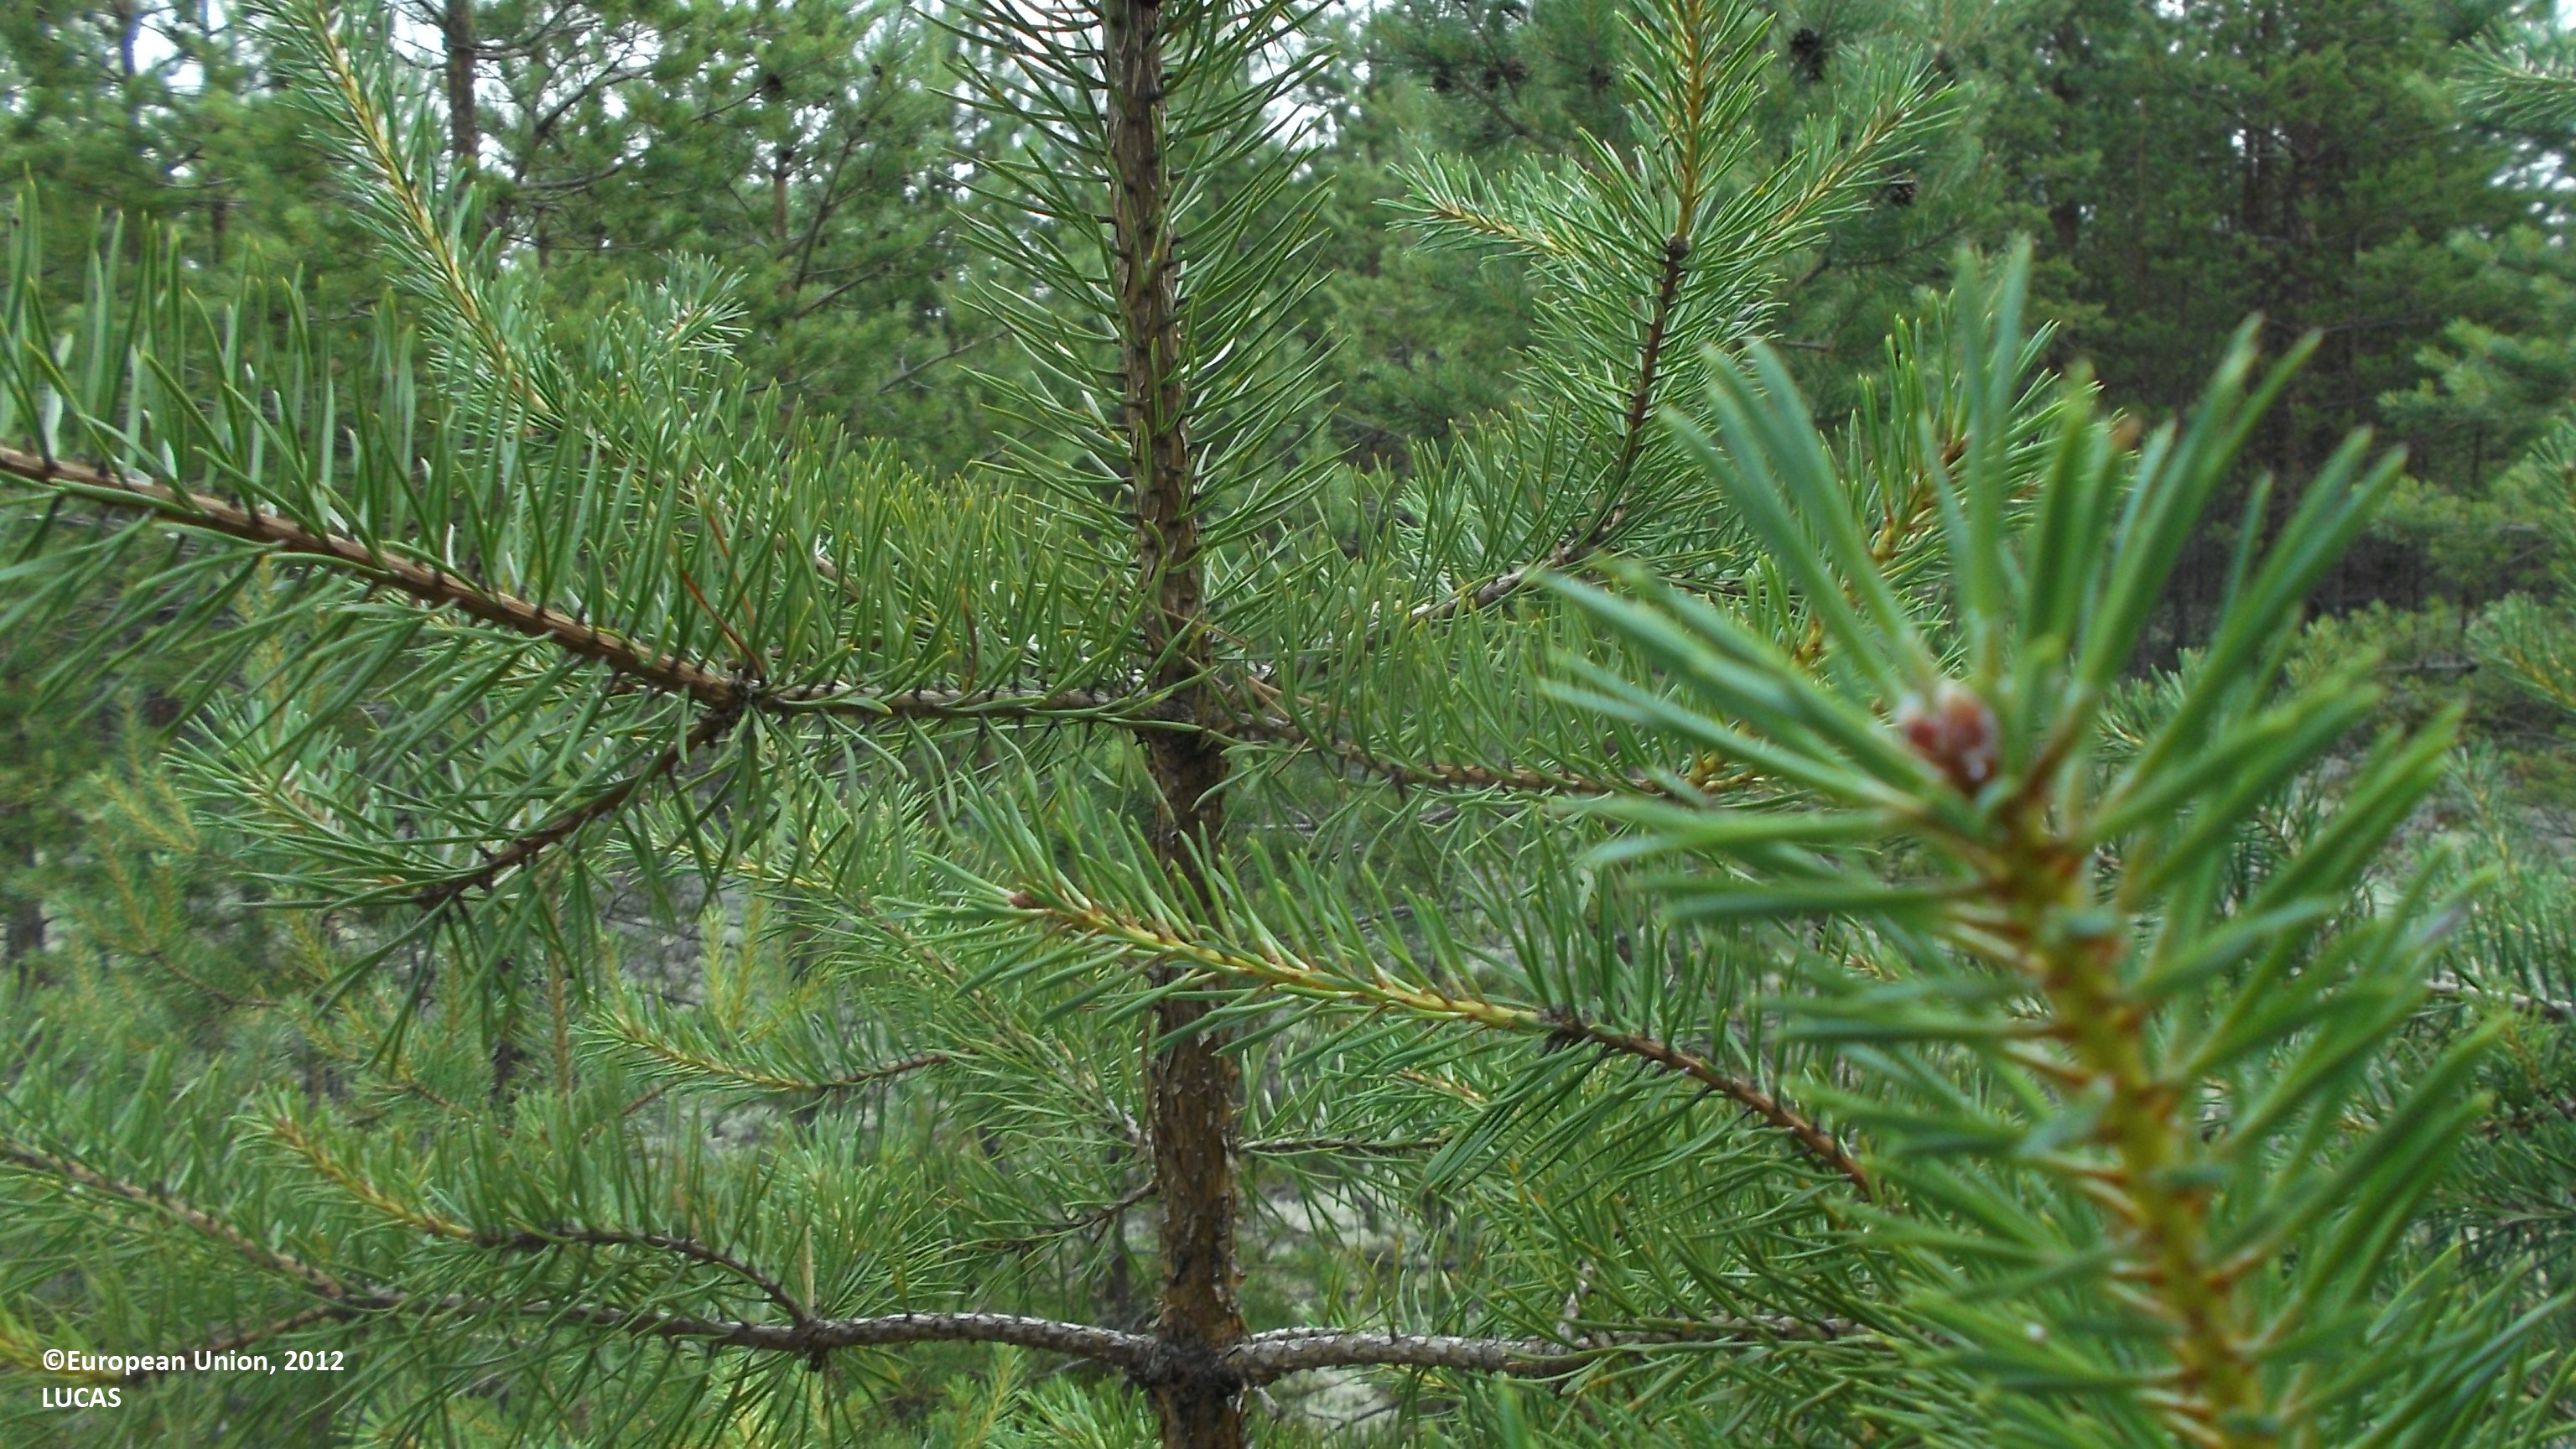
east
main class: Woodland
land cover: Pine dominated coniferous woodland
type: boreal forest
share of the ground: 25 - 50 %
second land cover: Lichens and moss
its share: 50 - 75 %
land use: Forestry
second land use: Semi-natural and natural areas not in use
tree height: > 5 m
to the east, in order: Pine dominated coniferous woodland; Lichens and moss; Sand; Electric lines; Spontaneously vegetated surfaces; Sand; Spontaneously vegetated surfaces; Electric lines; Ditches and canals; Other mixed woodland; Pine dominated mixed woodland; Ditches and canals; Pine dominated coniferous woodland; Ditches and canals; Pine dominated coniferous woodland
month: July
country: FI
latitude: 63.9815
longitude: 23.5224
